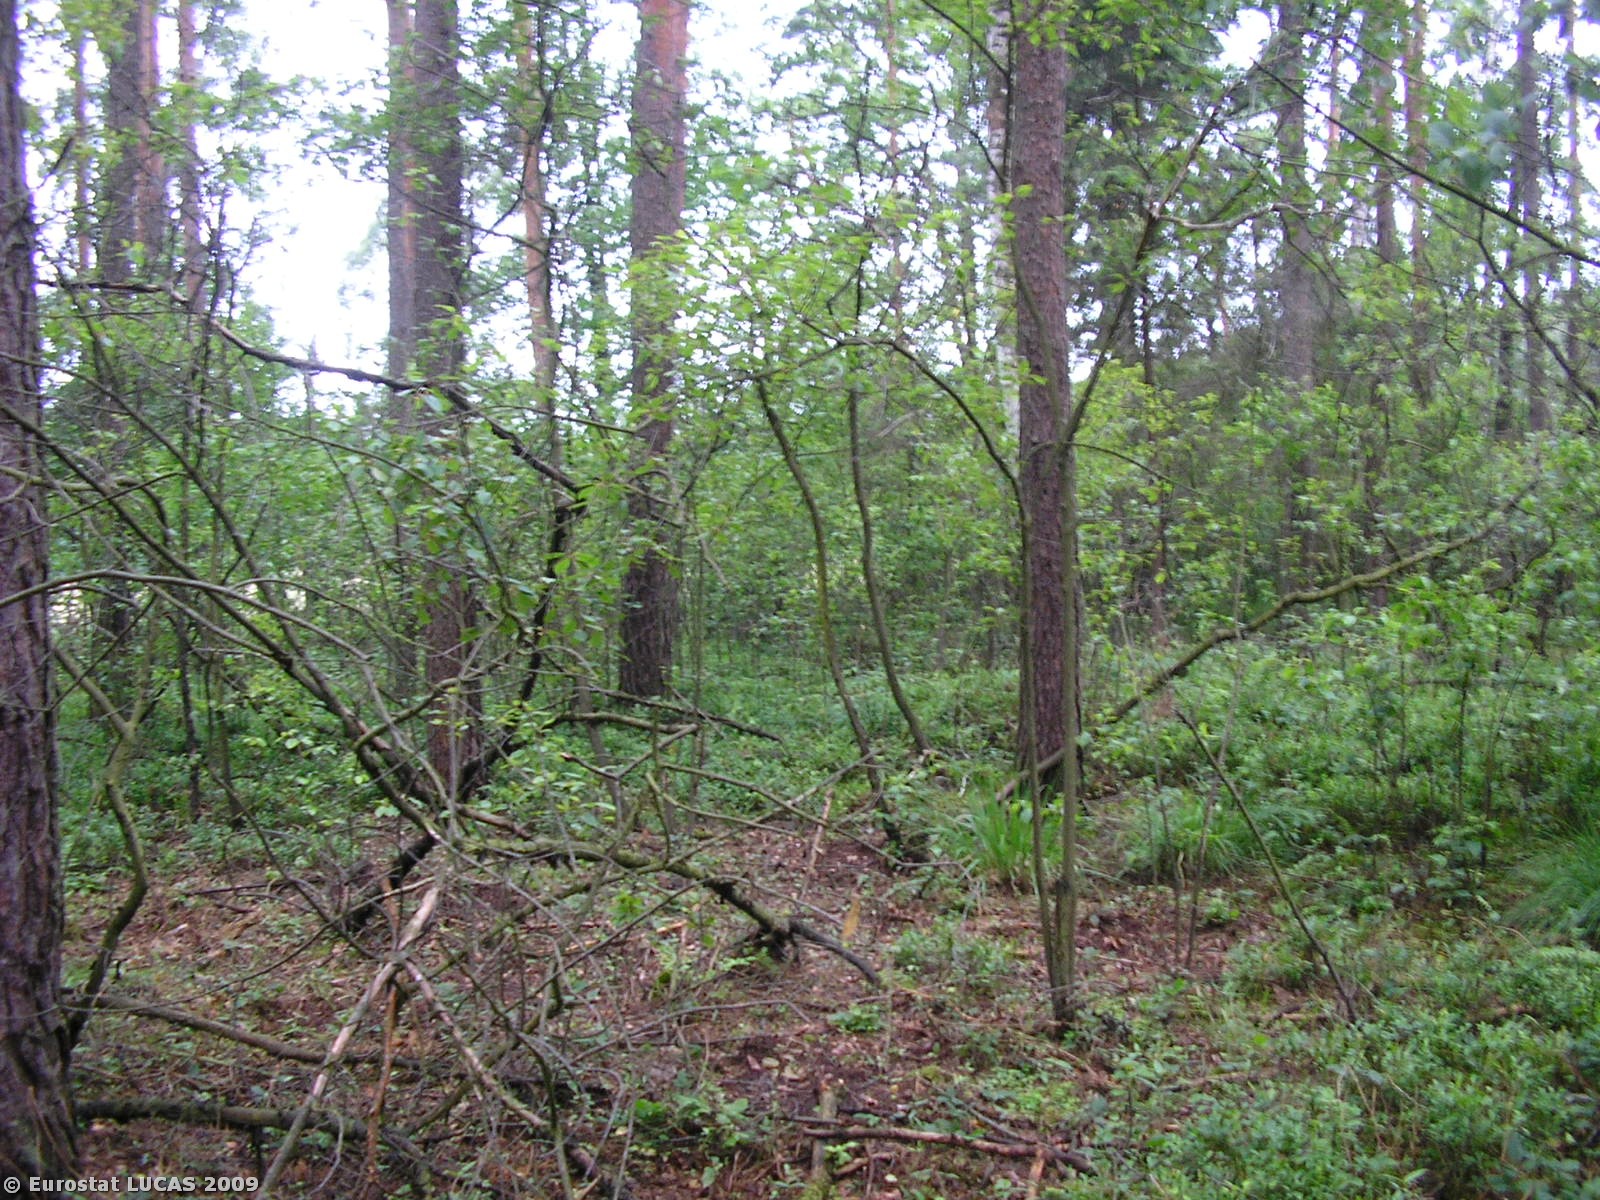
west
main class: Woodland
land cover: Coniferous woodland
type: hemiboreal forest and nemoral coniferous forest and mixed broadleaved-coniferous forest
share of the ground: > 75 %
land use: Forestry
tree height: > 5 m
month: June
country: PL
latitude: 51.2699
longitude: 18.3459
